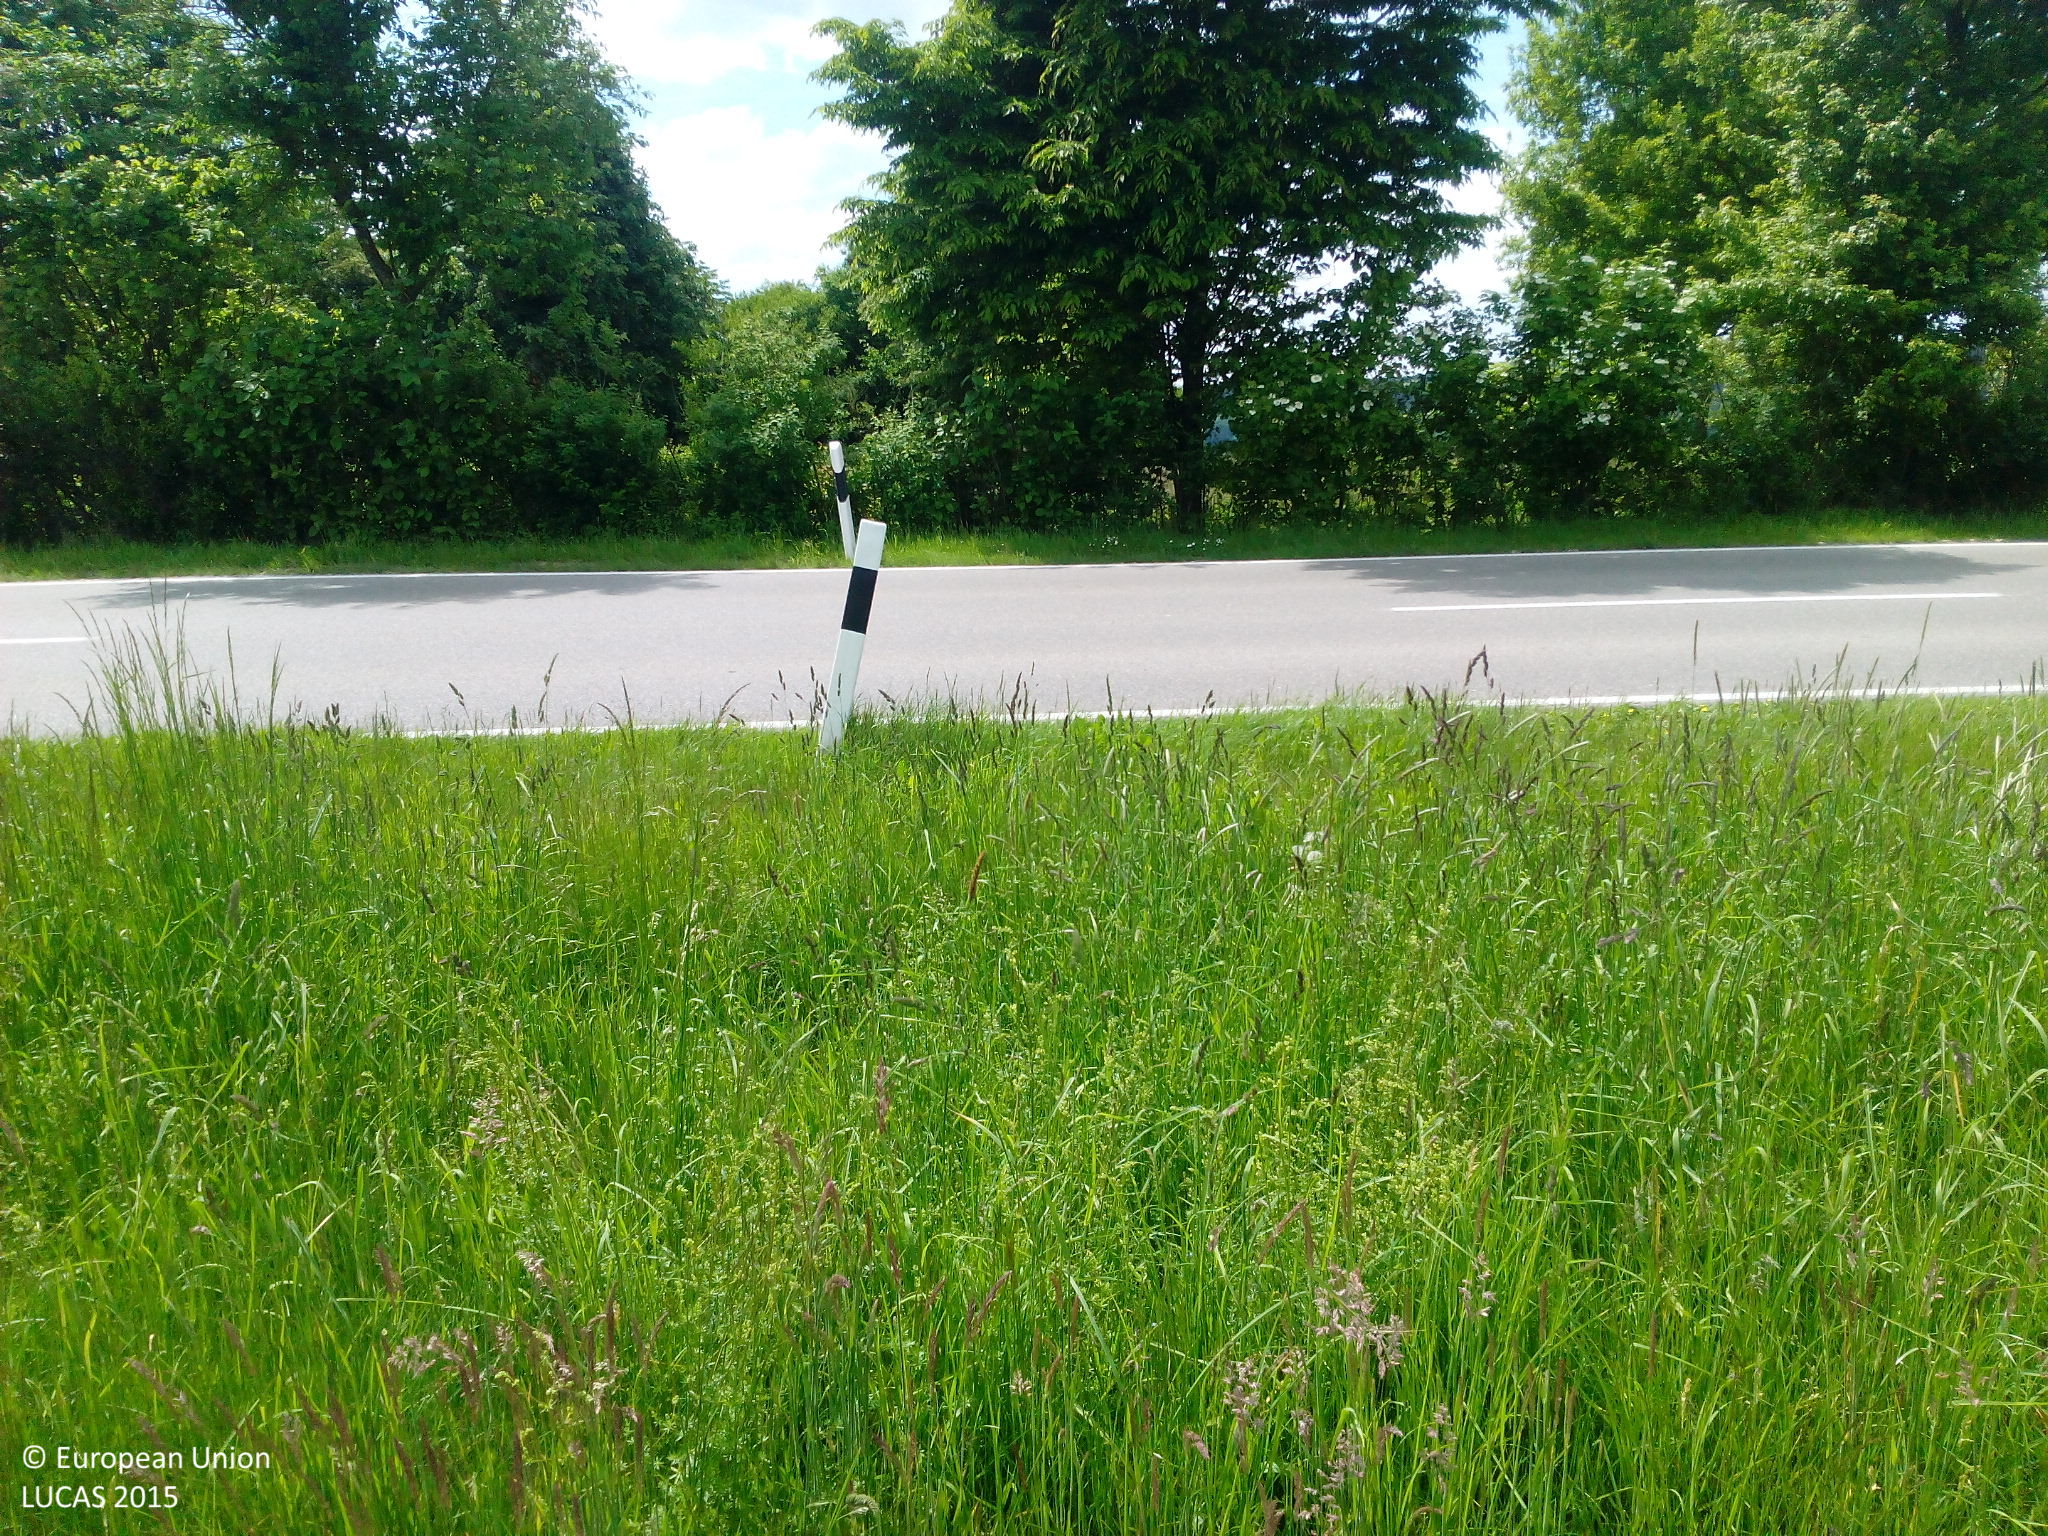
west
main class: Cropland
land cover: Rye
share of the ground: > 75 %
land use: Agriculture (excluding fallow land and kitchen gardens)
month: May
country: DE
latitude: 48.1692
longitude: 10.2553
